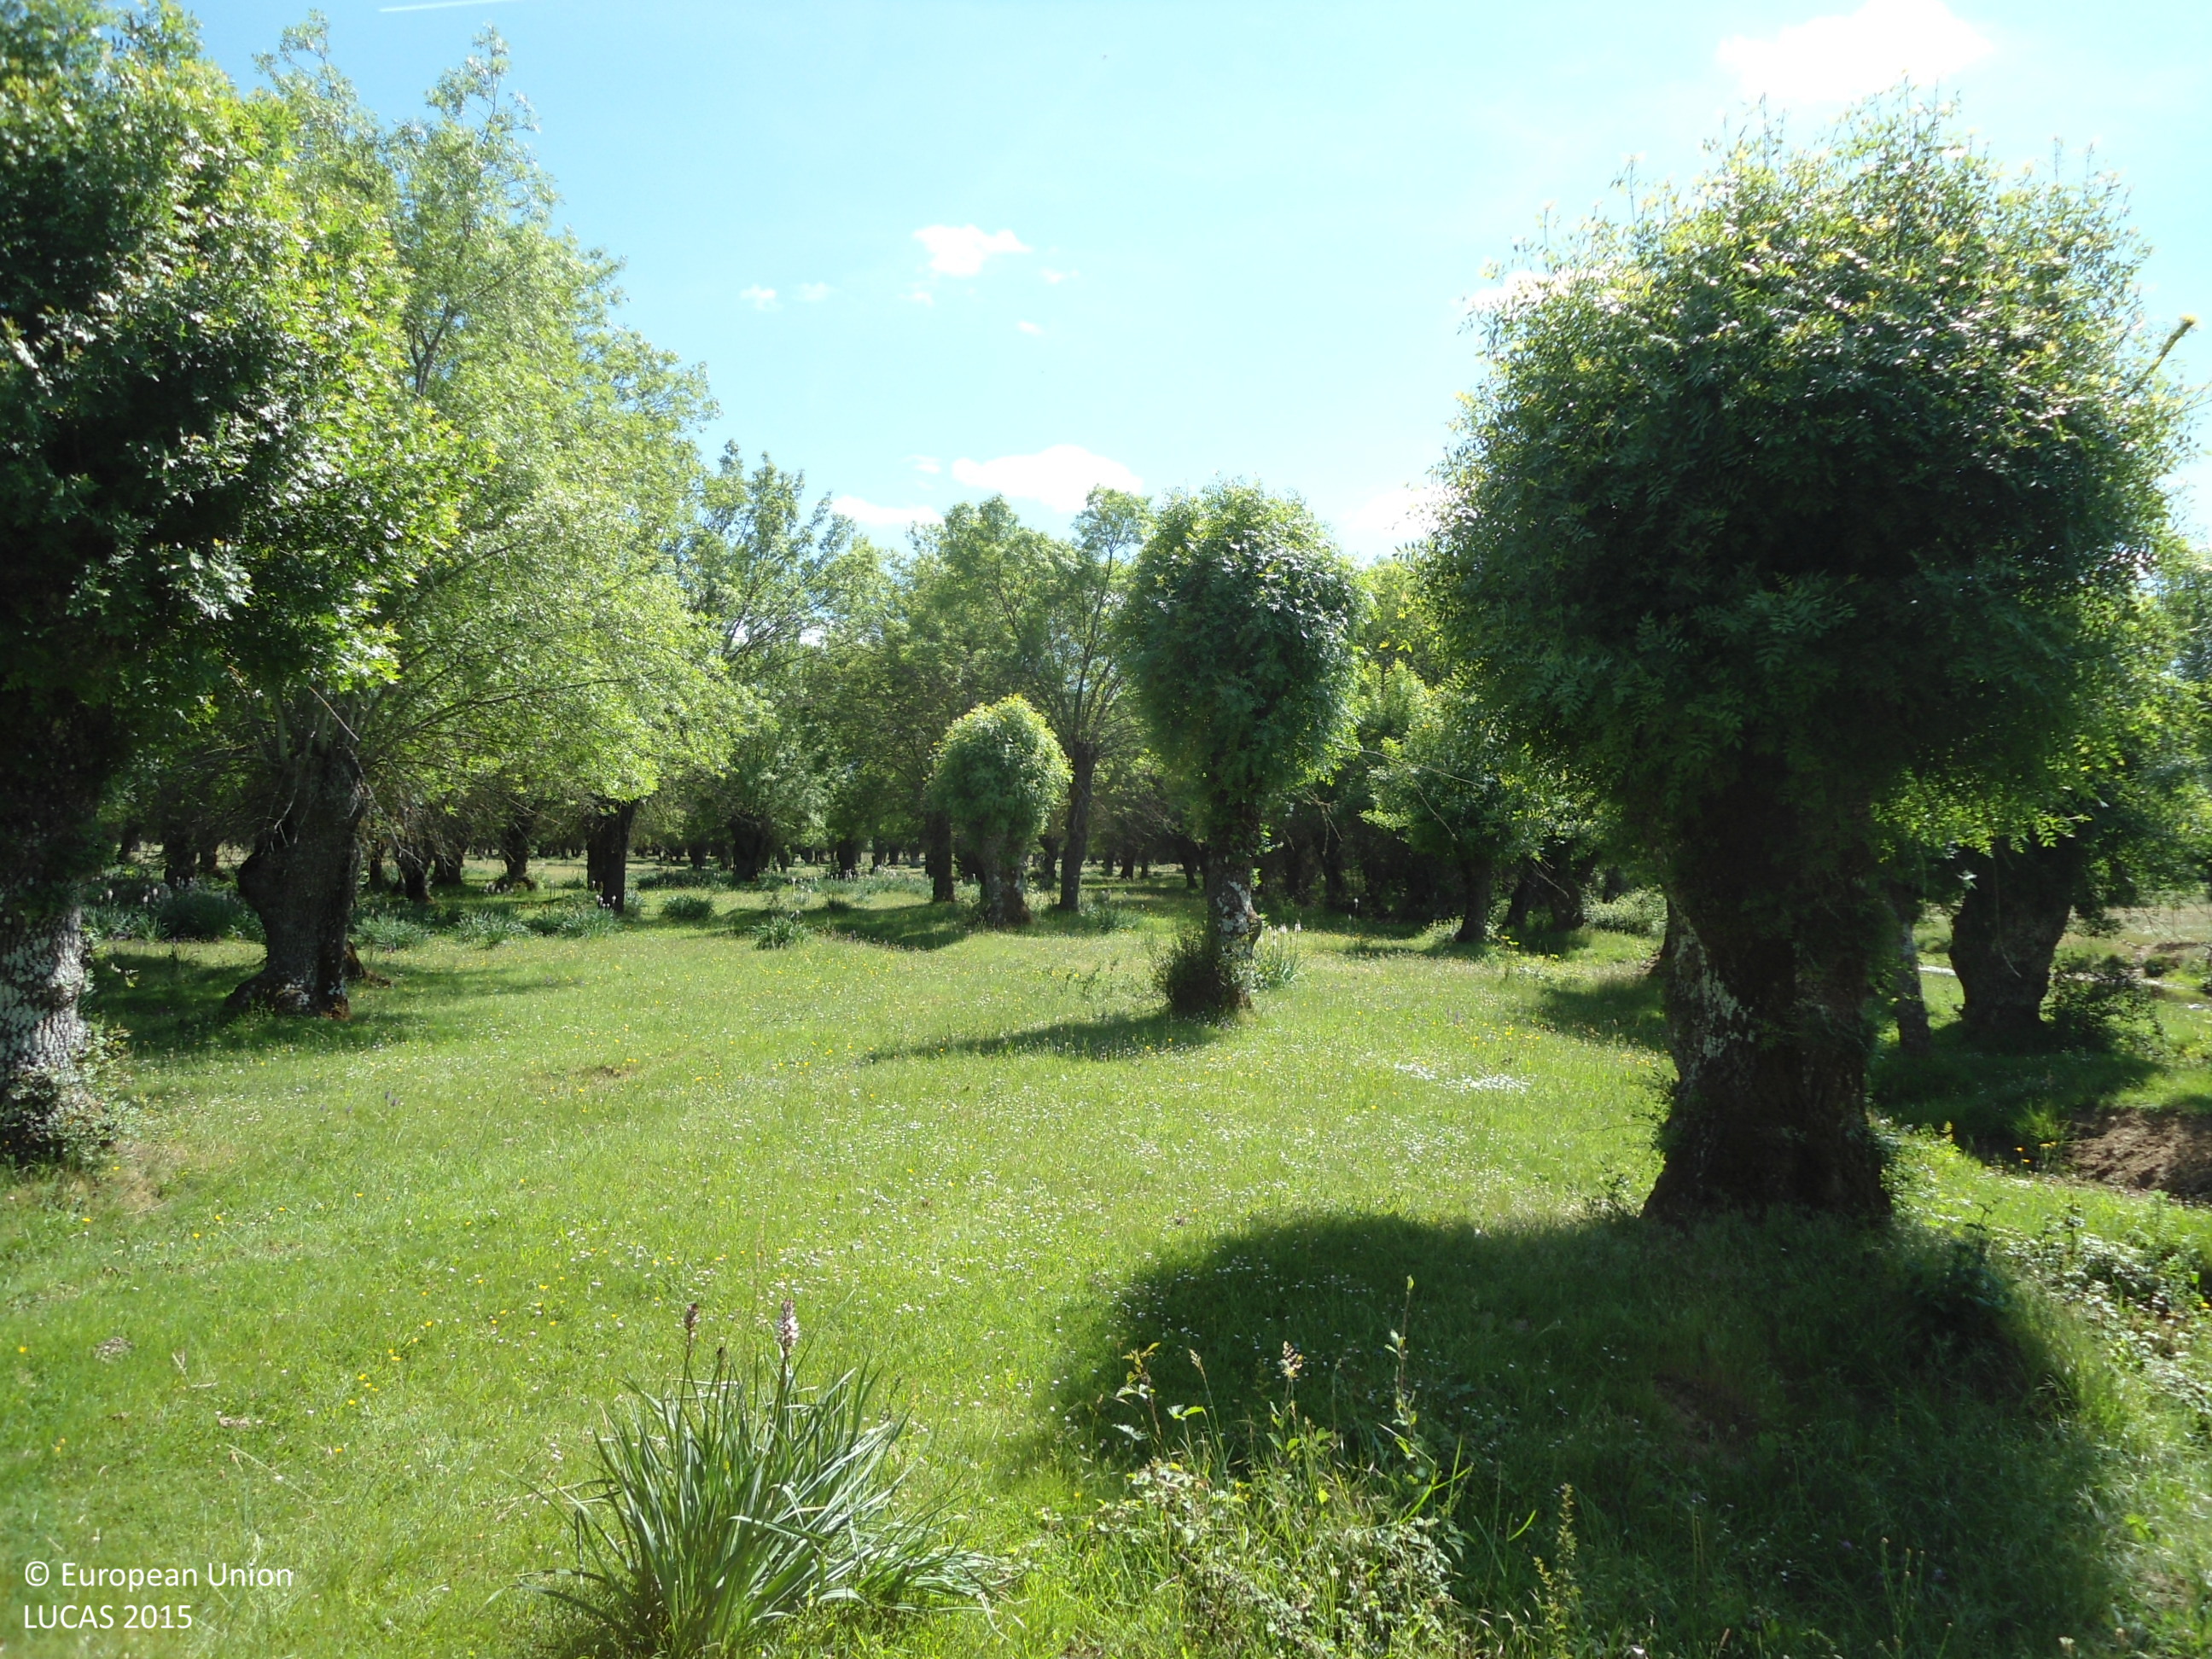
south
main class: Woodland
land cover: Broadleaved woodland
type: floodplain forest
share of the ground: > 75 %
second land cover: Grassland without tree/shrub cover
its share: > 75 %
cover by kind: broadleaved forest trees 75 %, herbaceous plants 25 %
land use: Forestry
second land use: Agriculture (excluding fallow land and kitchen gardens)
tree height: > 5 m
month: May
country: ES
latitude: 41.9233
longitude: -6.0025
